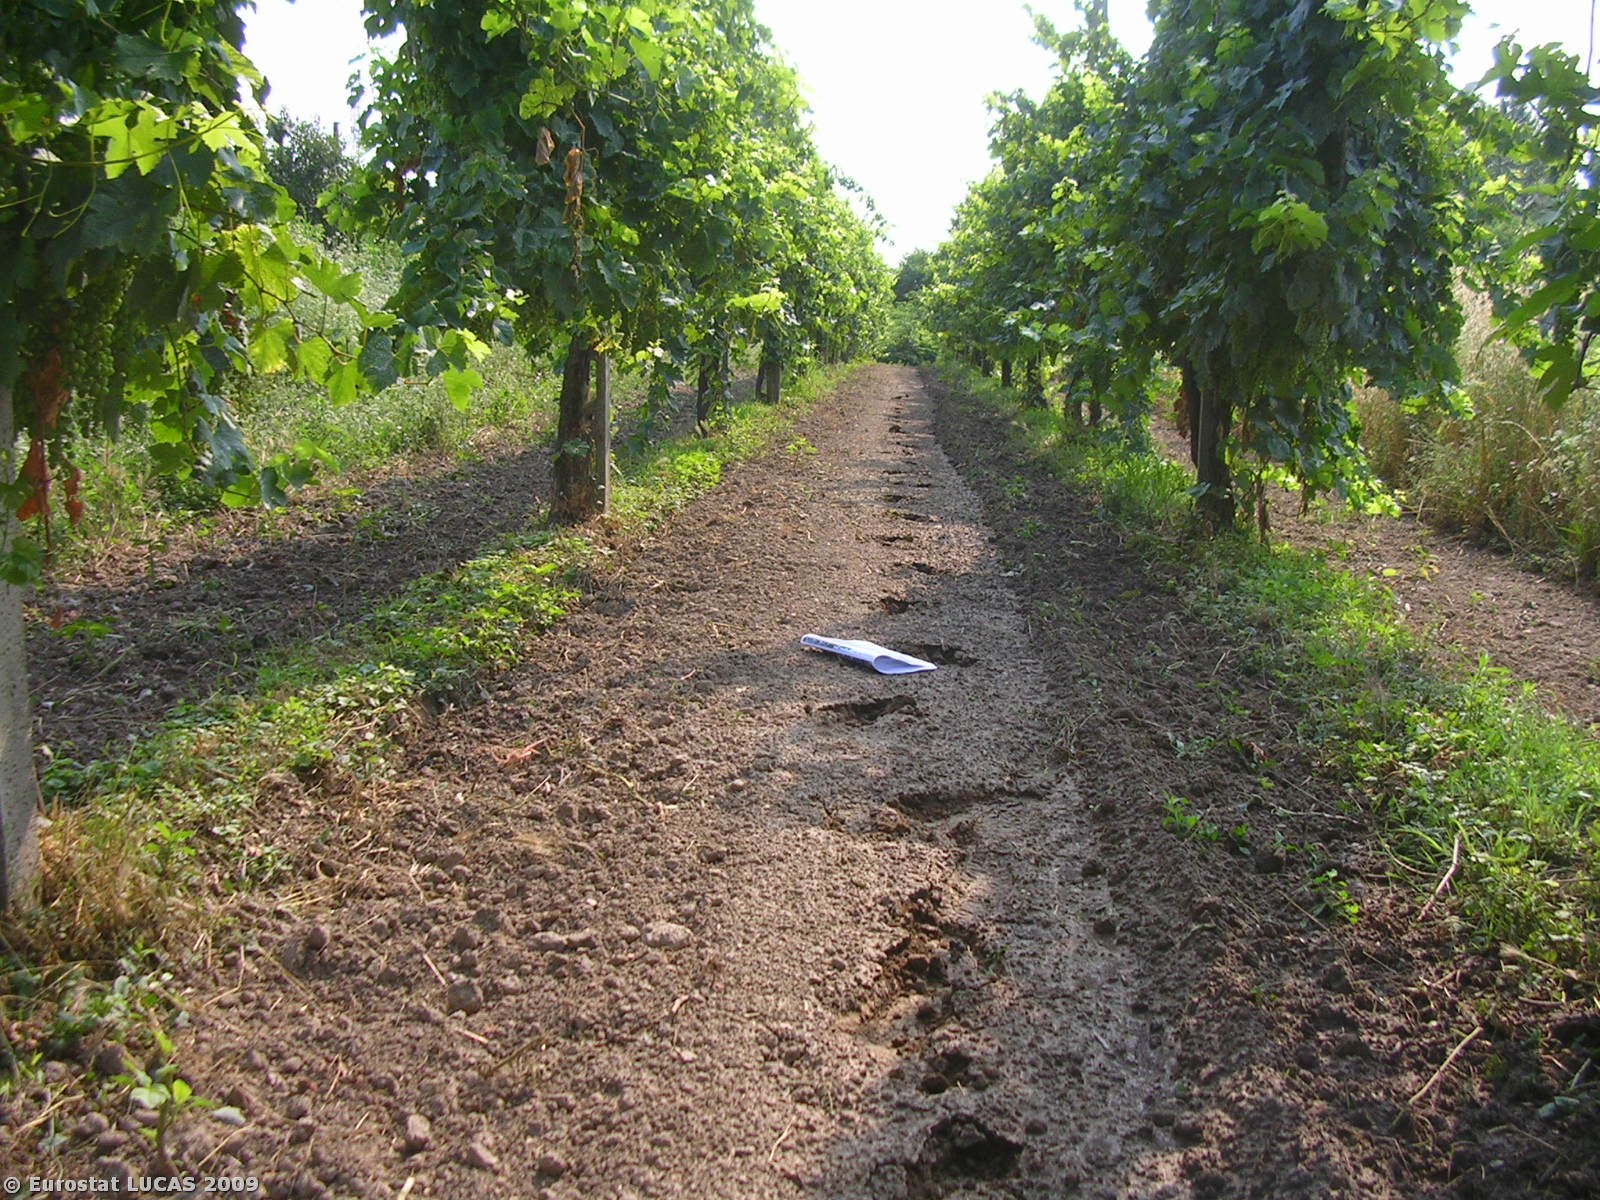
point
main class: Cropland
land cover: Vineyards
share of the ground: 50 - 75 %
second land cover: Bare land
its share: 50 - 75 %
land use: Agriculture (excluding fallow land and kitchen gardens)
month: July
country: IT
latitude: 45.2196
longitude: 11.7416
